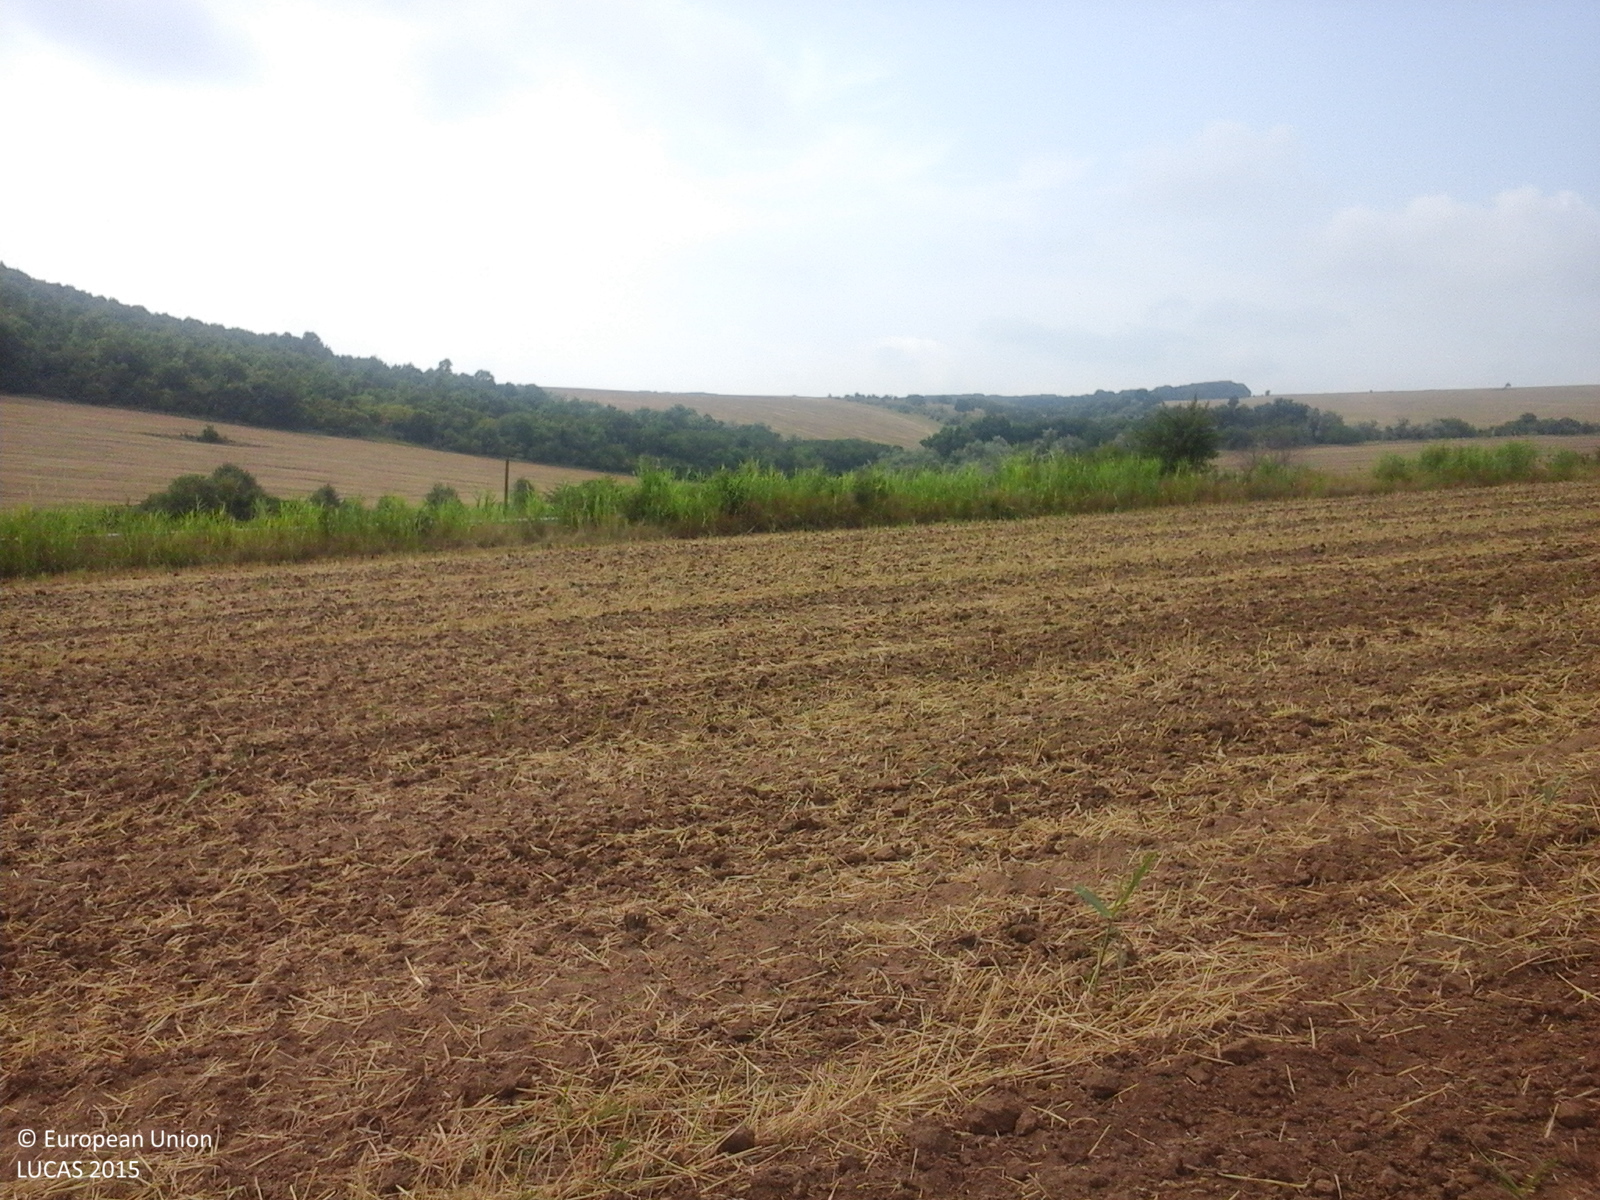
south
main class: Cropland
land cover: Durum wheat
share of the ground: < 10 %
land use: Agriculture (excluding fallow land and kitchen gardens)
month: July
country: RO
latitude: 44.9857
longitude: 28.4537
